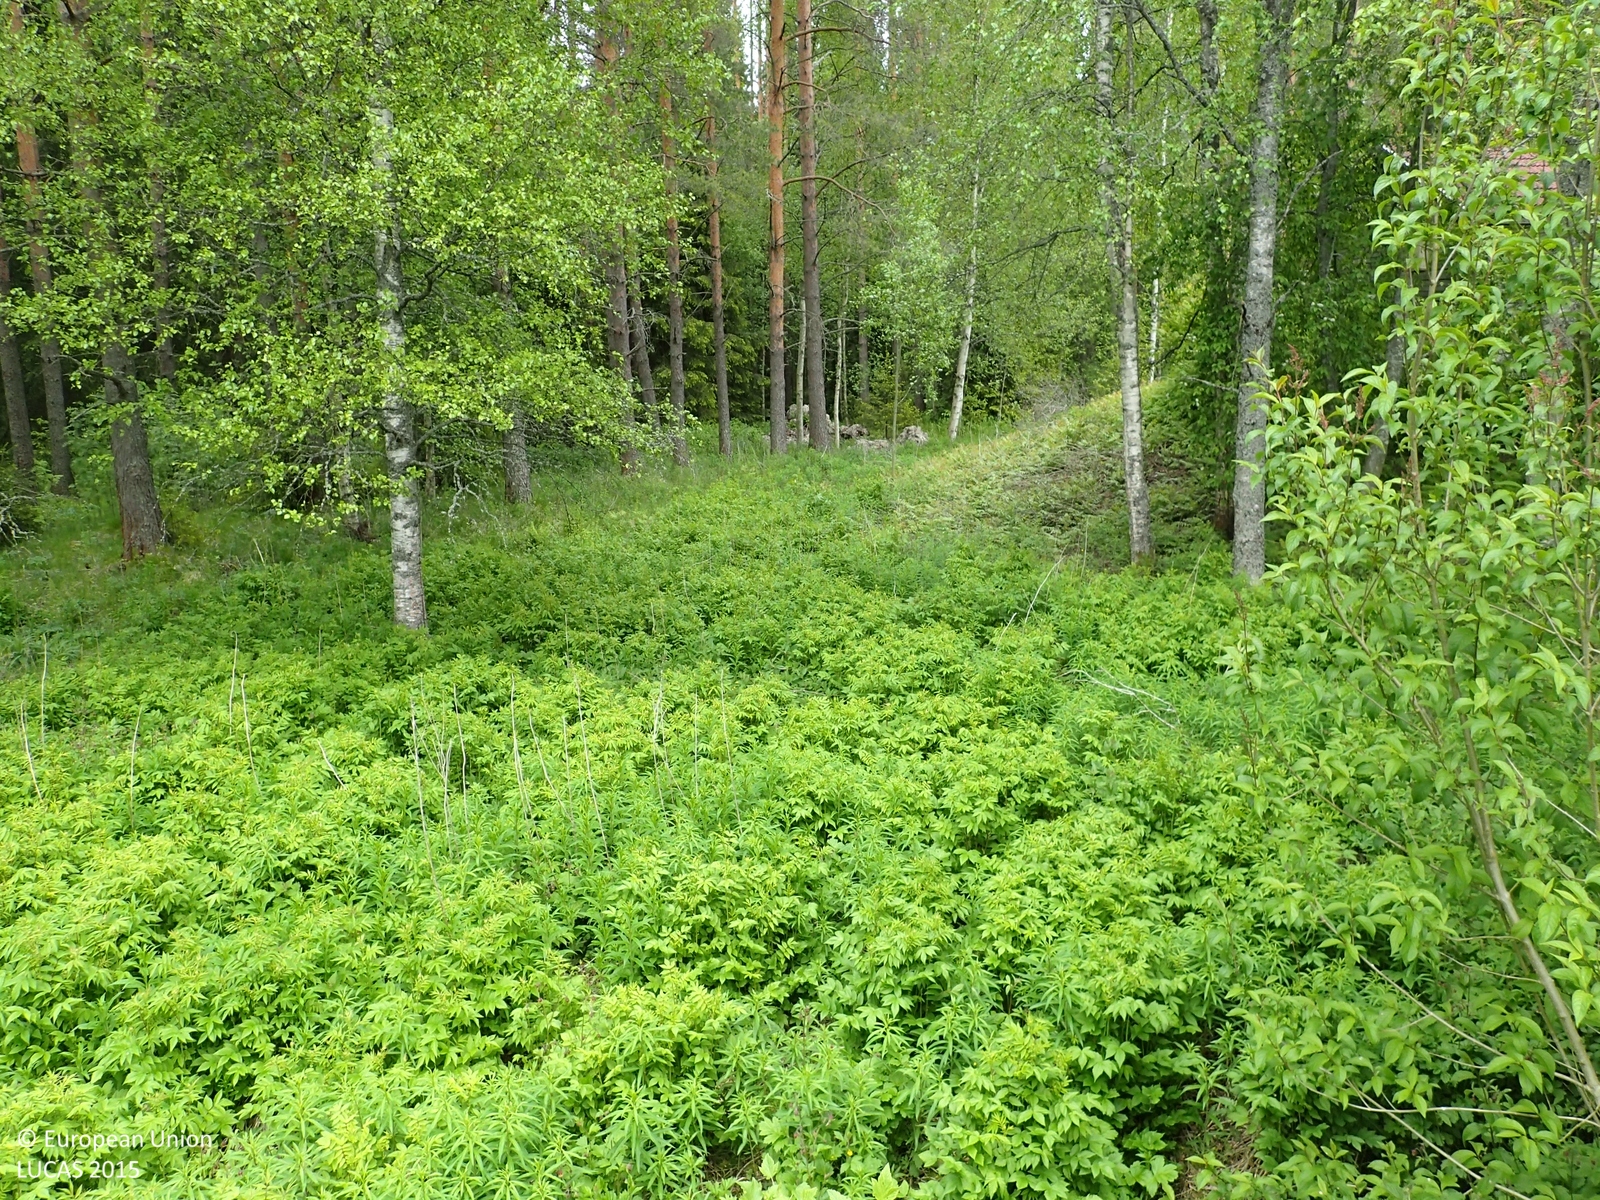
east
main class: Grassland
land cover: Grassland with sparse tree/shrub cover
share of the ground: > 75 %
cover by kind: herbaceous plants 95 %, broadleaved forest trees 5 %
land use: Residential
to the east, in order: Grassland with sparse tree/shrub cover; Ditches and canals; Grassland without tree/shrub cover; Other mixed woodland; Ditches and canals; Spruce dominated coniferous woodland; Rivers and streams; Spruce dominated mixed woodland; Ditches and canals; Grass margins; Paved roads, cycling and walking lanes; Grass margins; Ditches and canals; Pine dominated coniferous woodland; Ditches and canals; Pine dominated mixed woodland
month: June
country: FI
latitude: 62.4212
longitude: 22.4666
